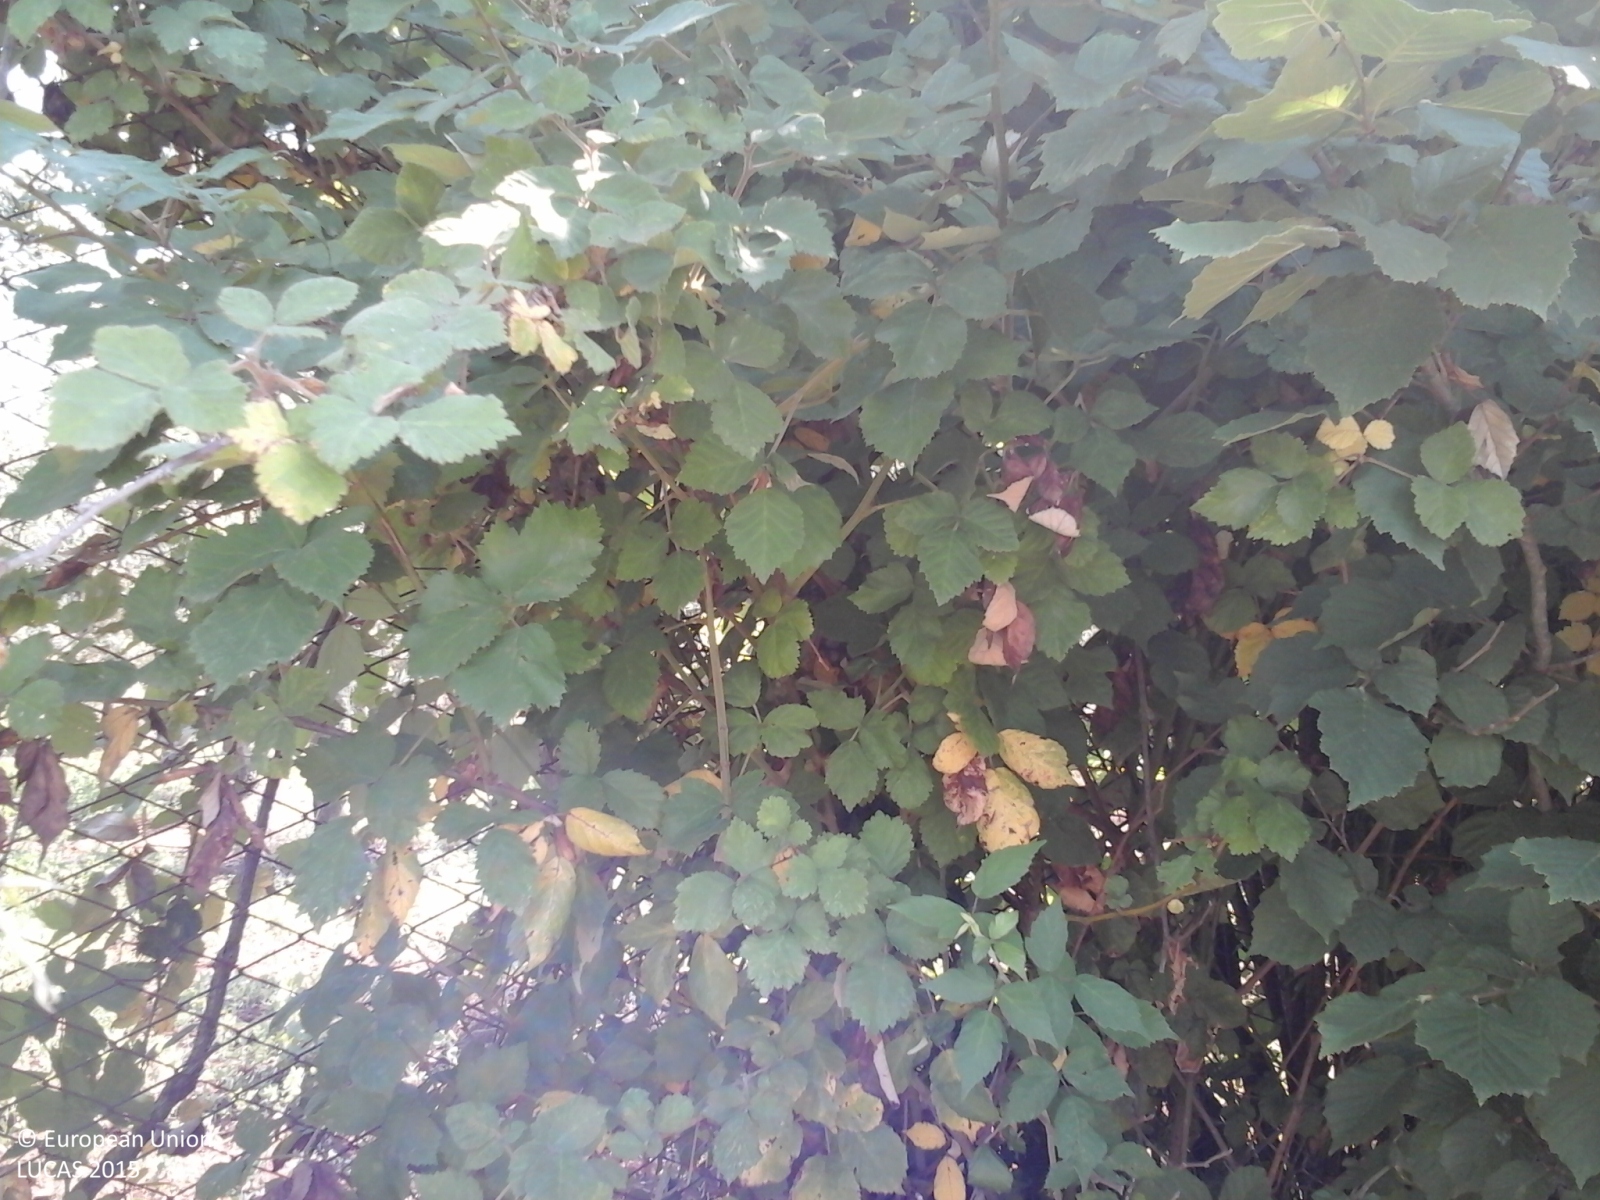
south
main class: Cropland
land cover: Olive groves
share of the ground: 25 - 50 %
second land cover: Grassland without tree/shrub cover
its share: > 75 %
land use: Agriculture (excluding fallow land and kitchen gardens)
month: July
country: IT
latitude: 41.8395
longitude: 12.7475
